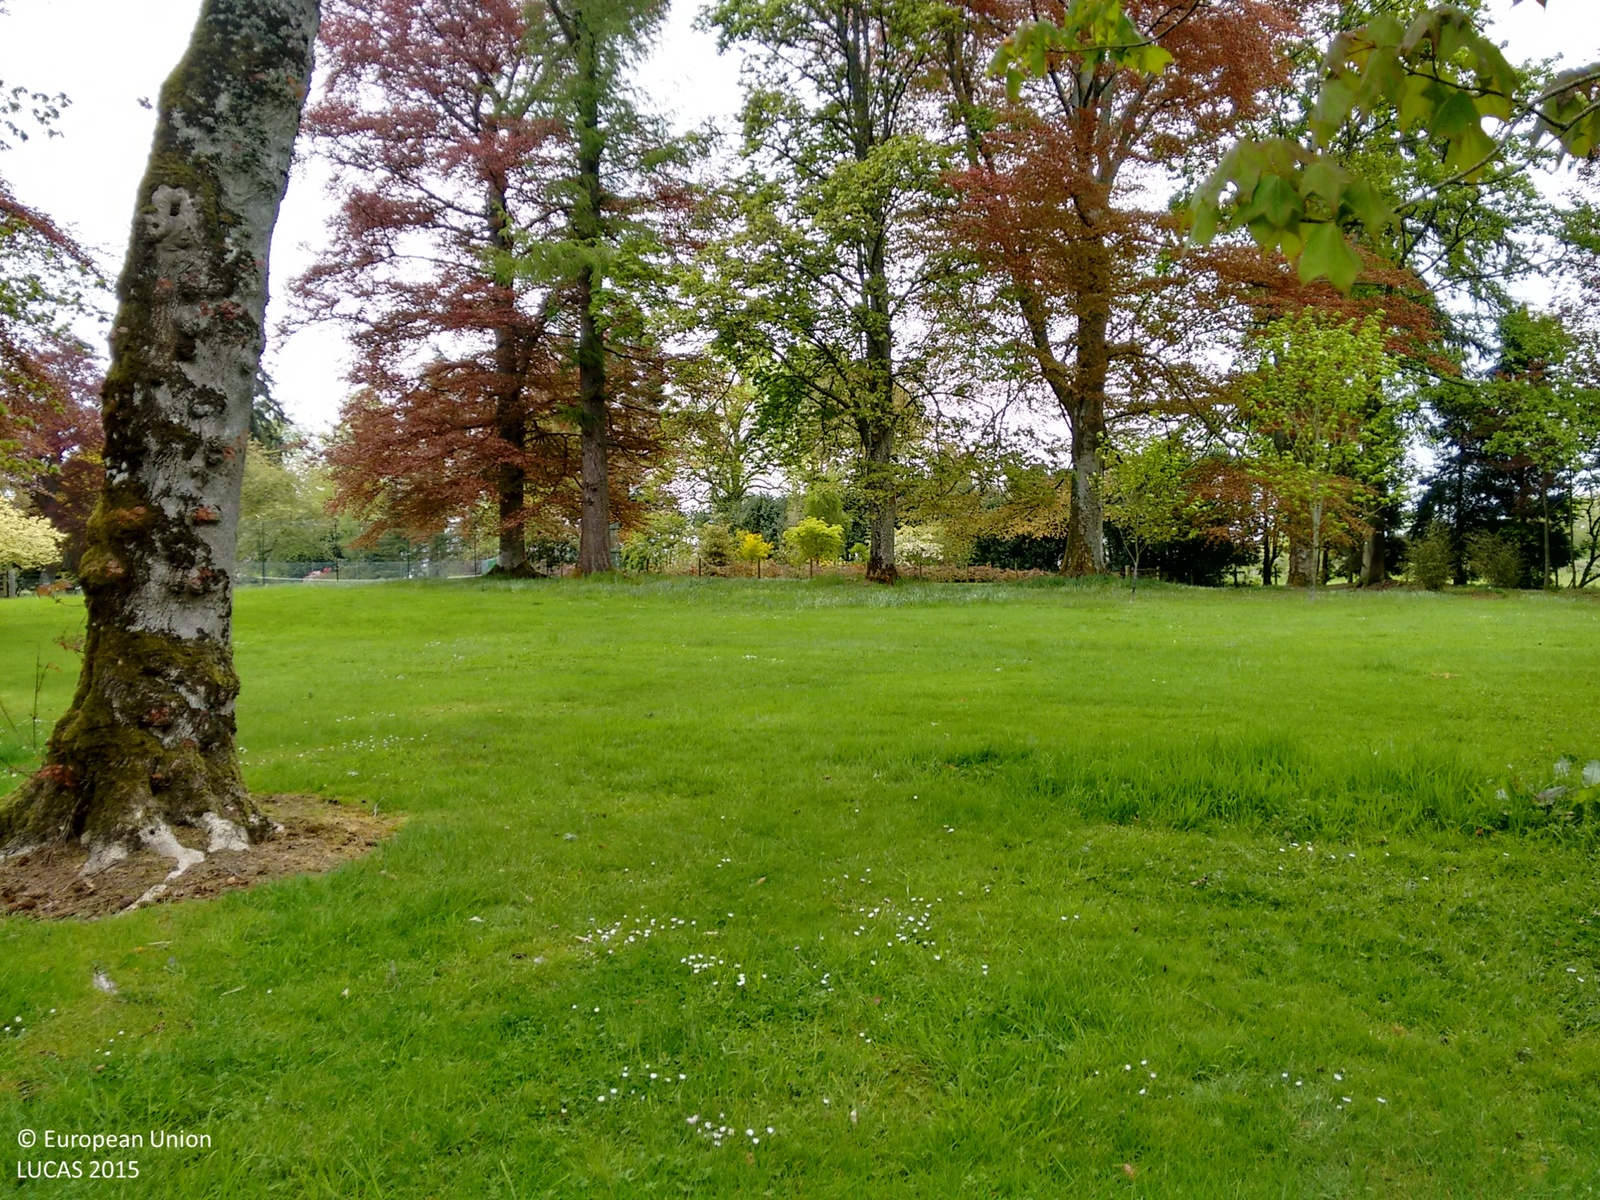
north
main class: Woodland
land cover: Other mixed woodland
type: exotic forest
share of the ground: > 75 %
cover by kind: broadleaved forest trees 45 %, coniferous forest trees 20 %, shrubs 20 %, herbaceous plants 15 %
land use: Residential
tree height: > 5 m
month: May
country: GB
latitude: 56.3171
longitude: -3.7752
